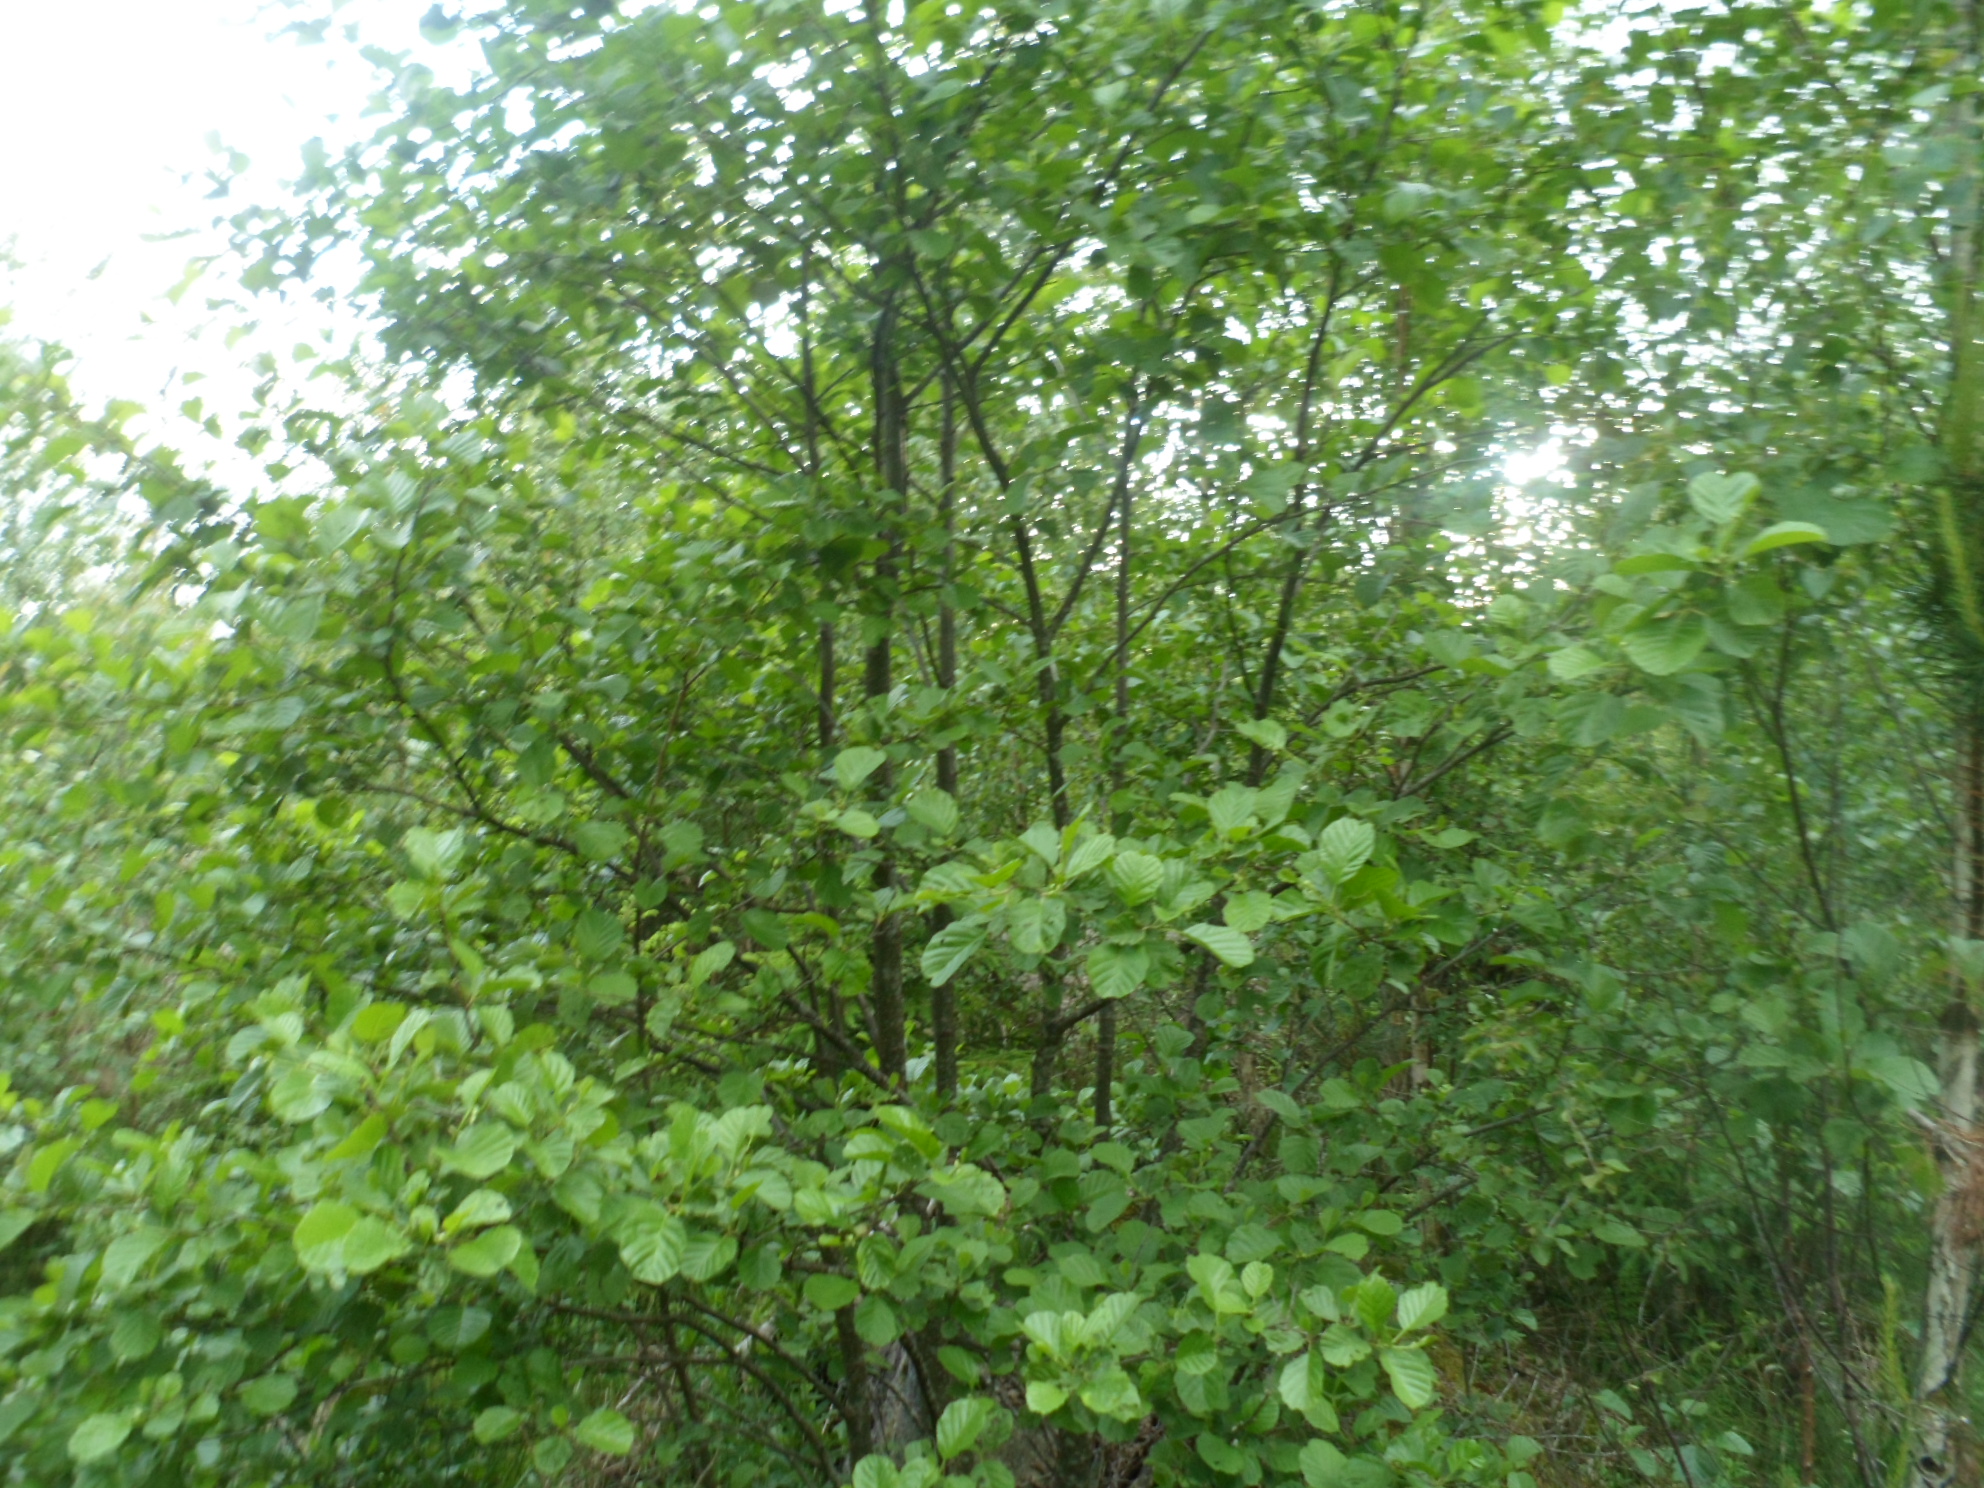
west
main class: Woodland
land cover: Spruce dominated mixed woodland
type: boreal forest
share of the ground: > 75 %
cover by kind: broadleaved forest trees 45 %, coniferous forest trees 35 %, herbaceous plants 15 %, shrubs 5 %
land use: Forestry
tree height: < 5 m
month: June
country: SE
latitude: 57.0912
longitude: 14.2046
